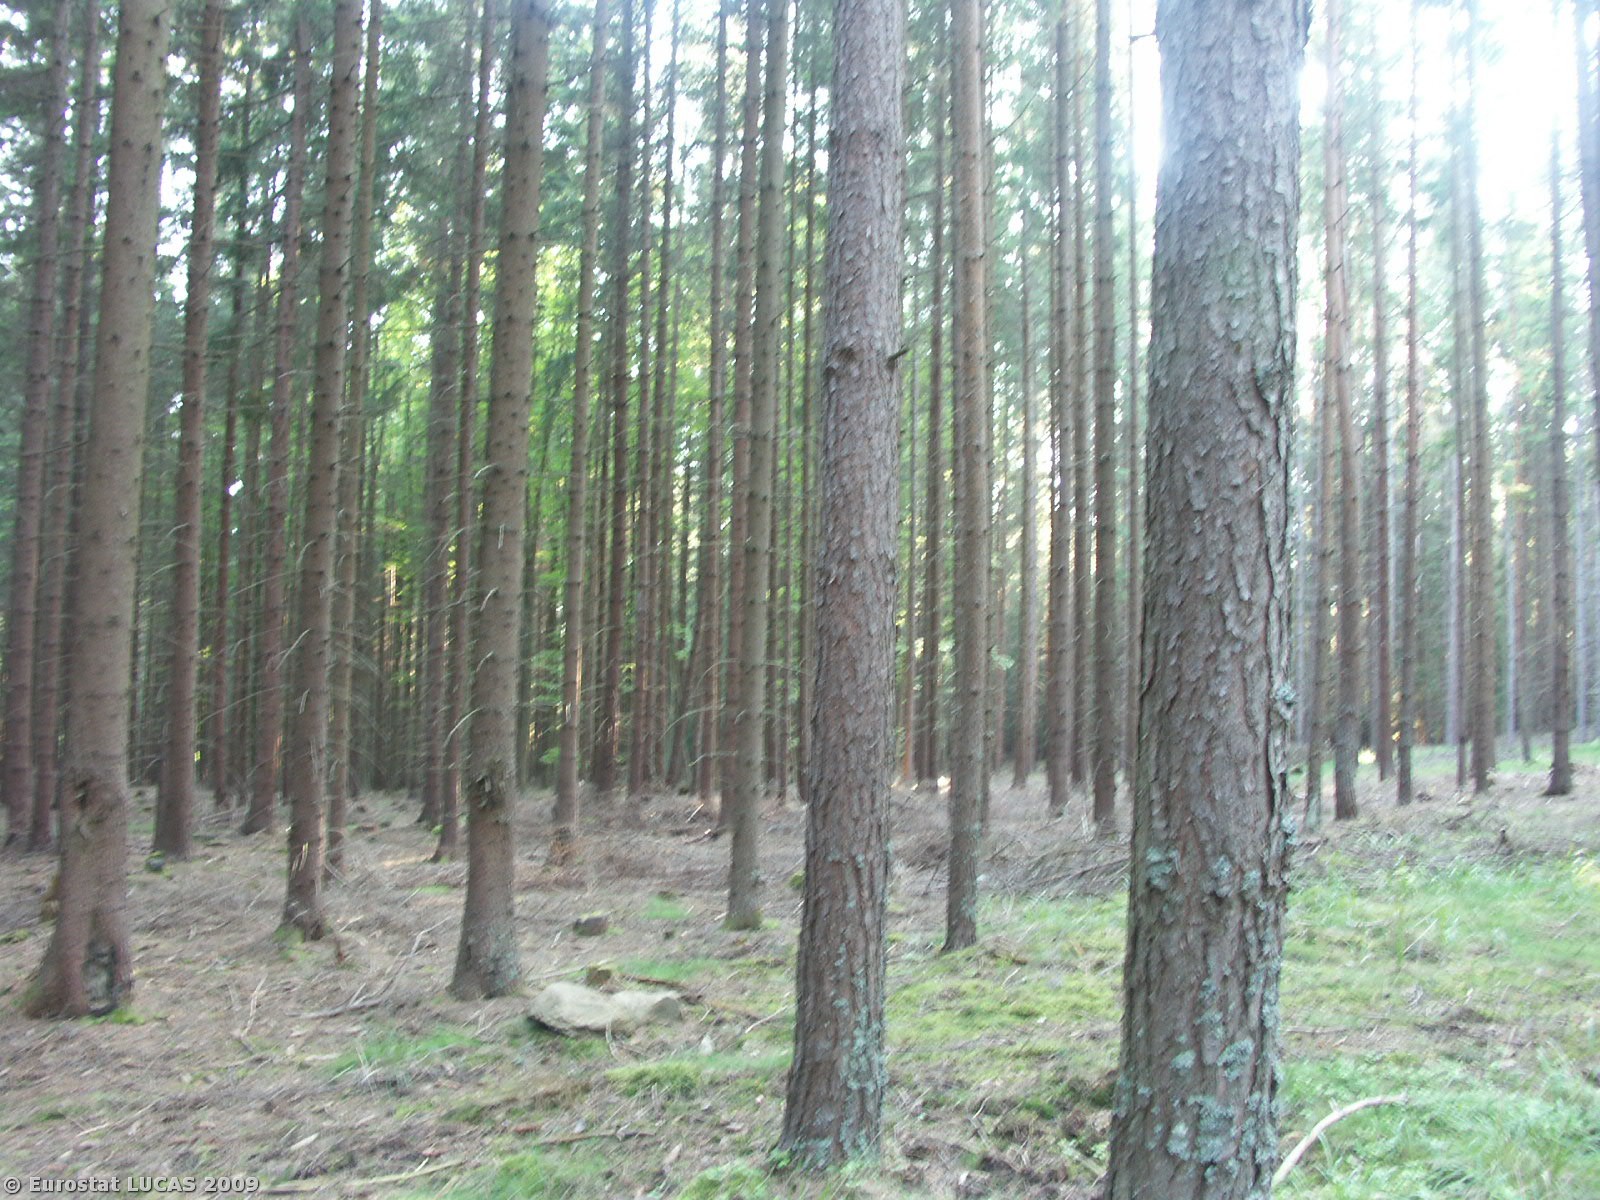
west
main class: Woodland
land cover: Coniferous woodland
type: hemiboreal forest and nemoral coniferous forest and mixed broadleaved-coniferous forest
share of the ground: > 75 %
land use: Forestry
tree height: > 5 m
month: May
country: CZ
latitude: 49.0492
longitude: 15.3528
